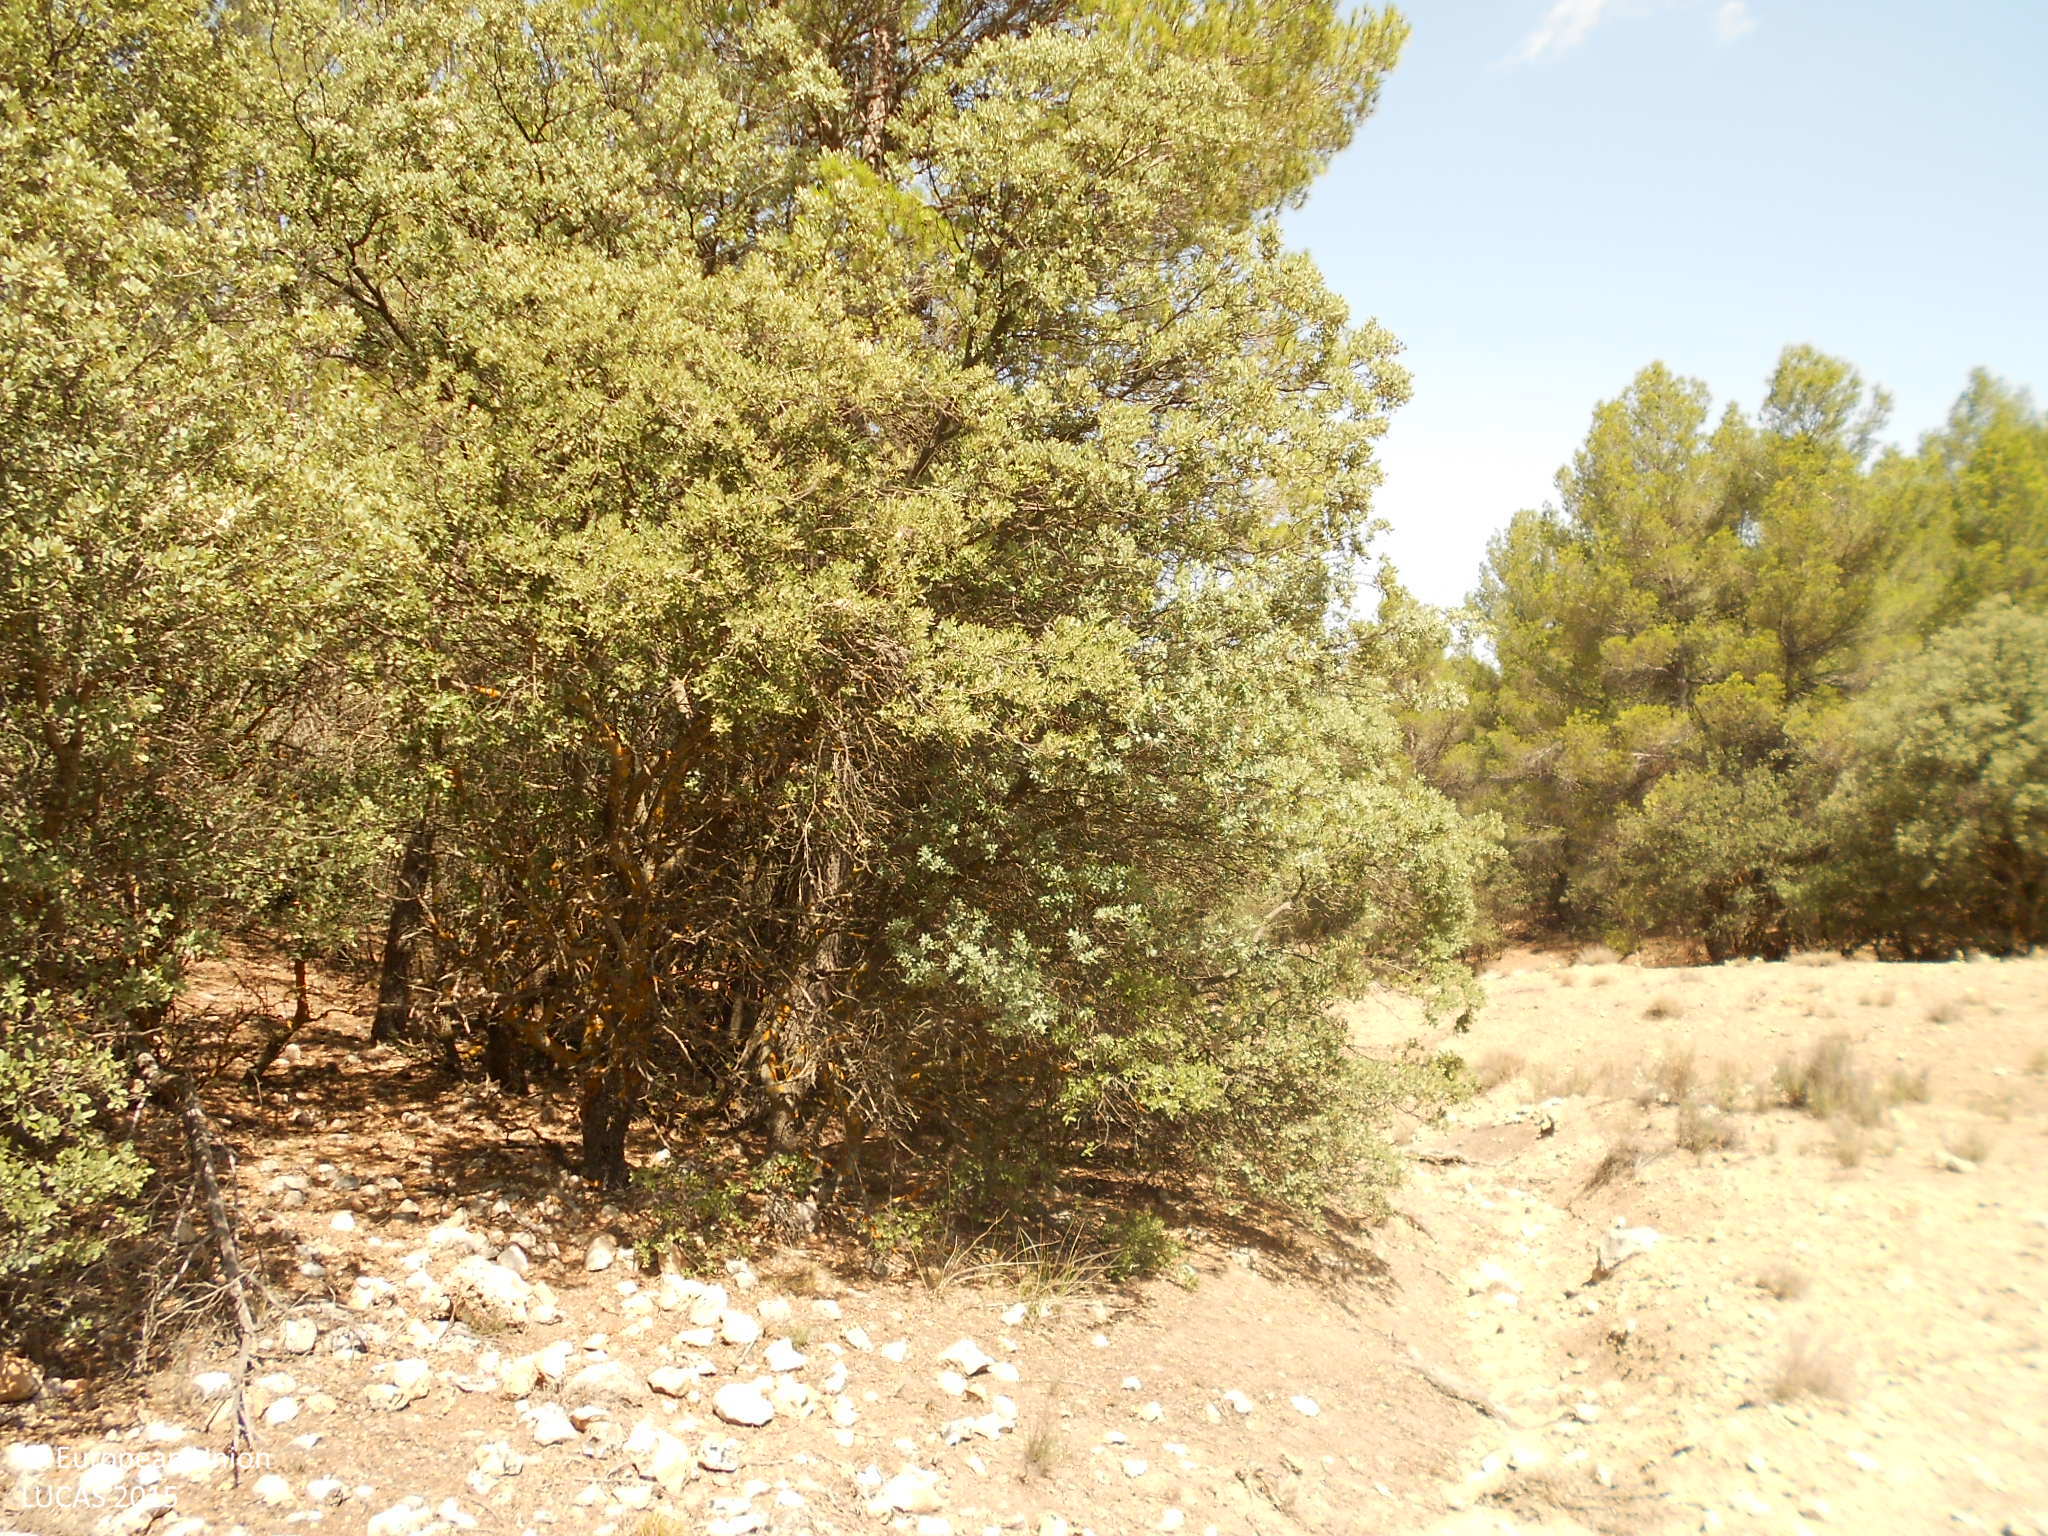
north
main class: Woodland
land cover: Other mixed woodland
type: coniferous forest of the mediterranean region
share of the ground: > 75 %
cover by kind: coniferous forest trees 40 %, broadleaved forest trees 40 %, shrubs 20 %
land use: Semi-natural and natural areas not in use
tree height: > 5 m
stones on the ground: 25 - 50 %
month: August
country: ES
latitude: 37.6859
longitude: -2.2443
